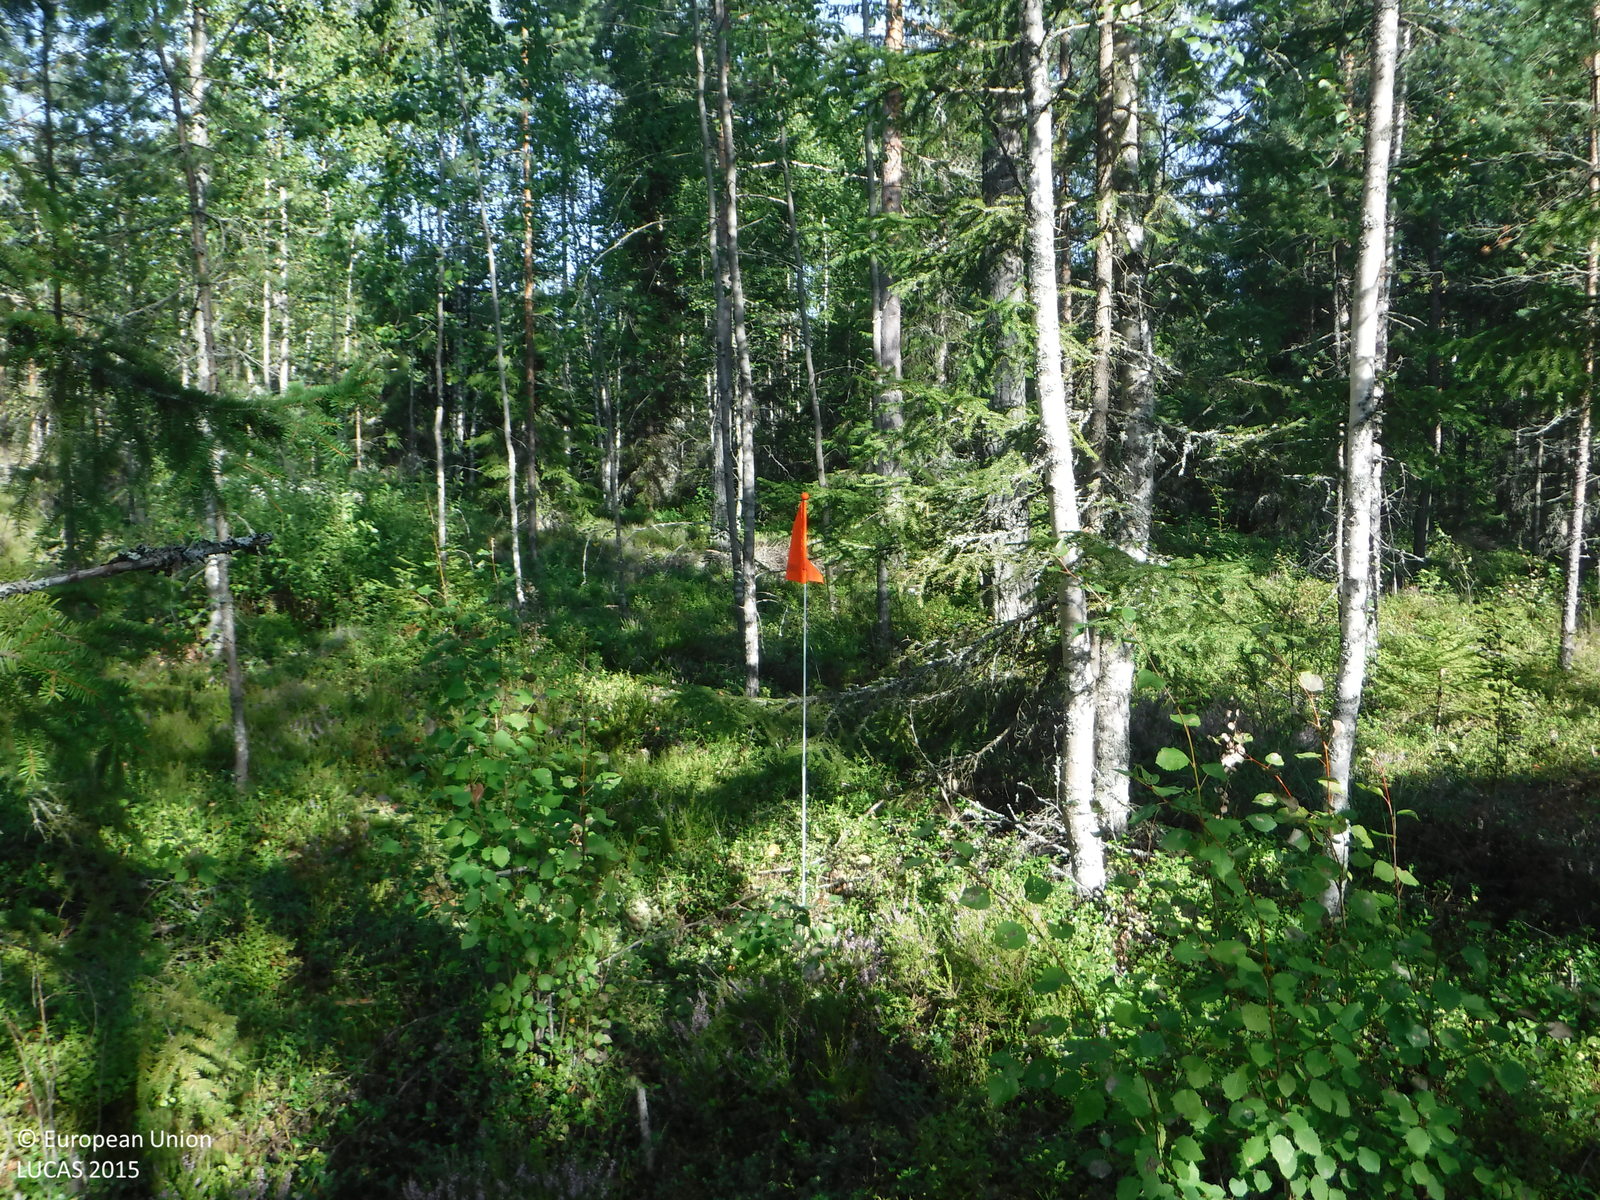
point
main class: Woodland
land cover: Pine dominated mixed woodland
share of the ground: 25 - 50 %
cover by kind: shrubs 55 %, coniferous forest trees 30 %, broadleaved forest trees 10 %, lichens and mosses 5 %
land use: Forestry
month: August
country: FI
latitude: 61.0558
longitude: 21.5195
